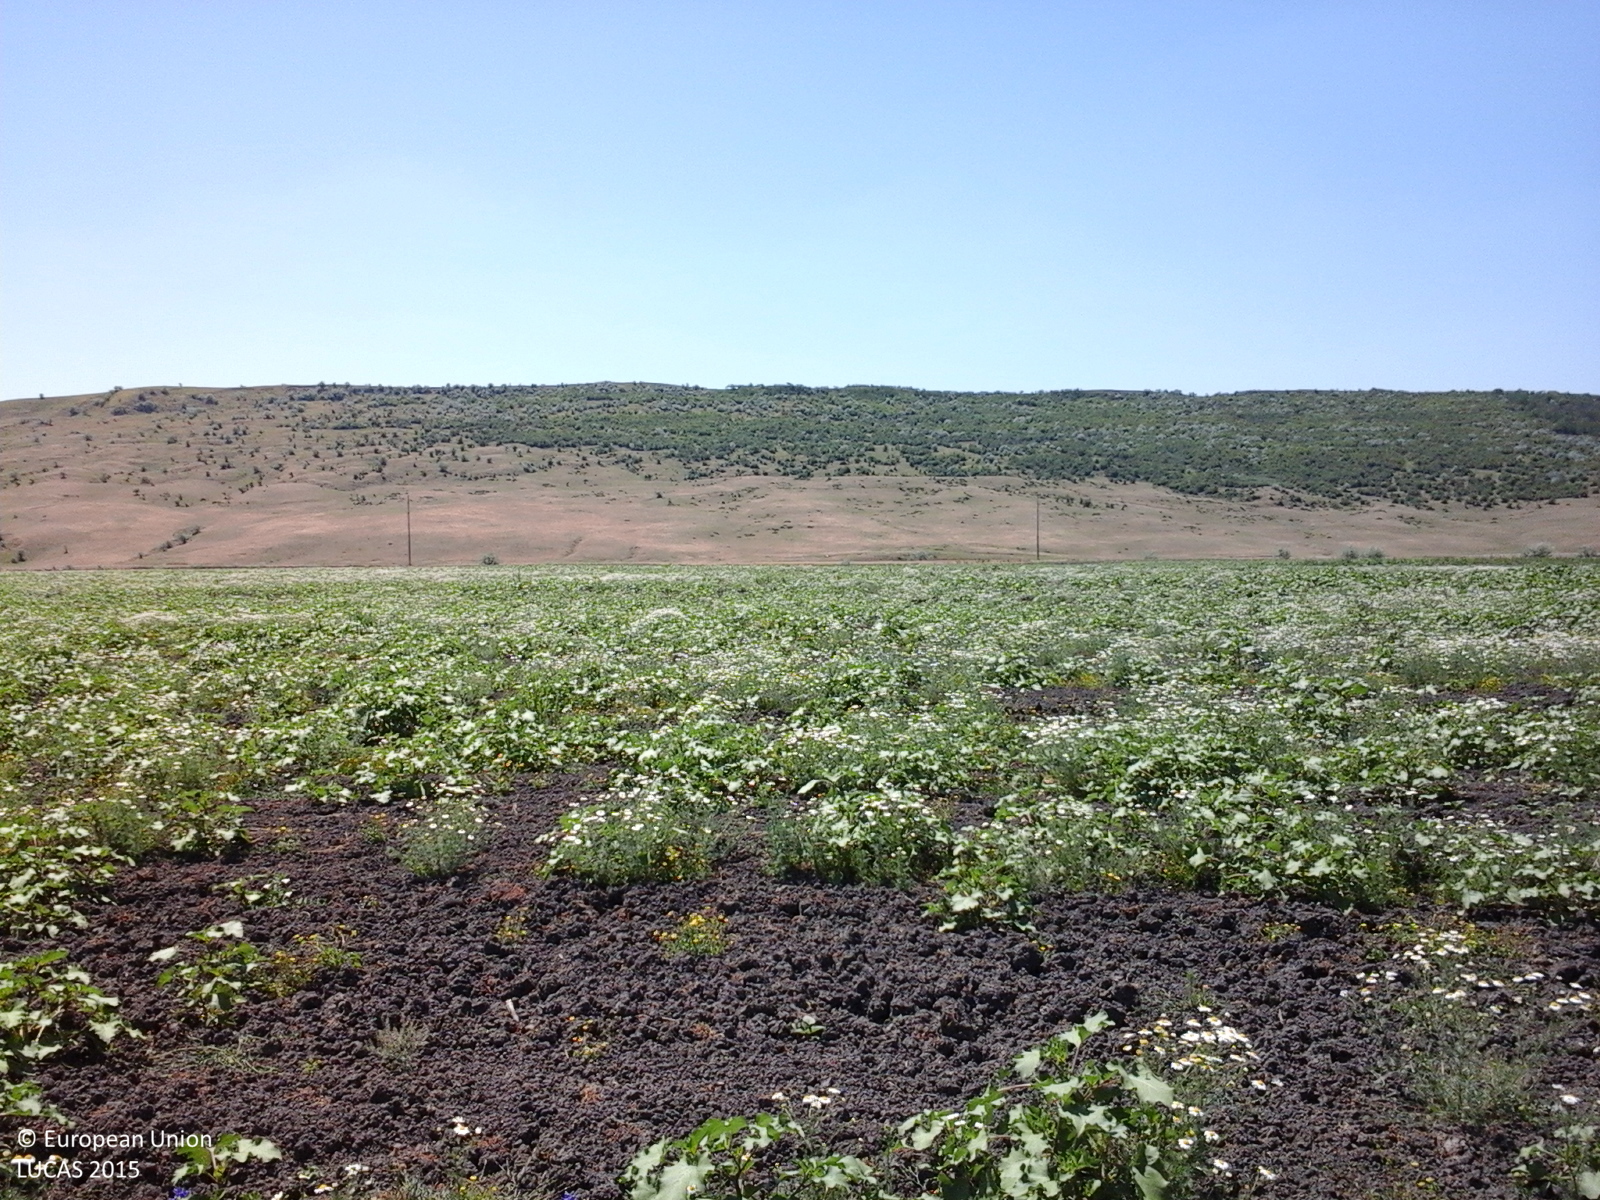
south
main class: Cropland
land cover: Other fresh vegetables
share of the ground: 50 - 75 %
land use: Agriculture (excluding fallow land and kitchen gardens)
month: June
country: RO
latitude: 47.0098
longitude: 27.9520
